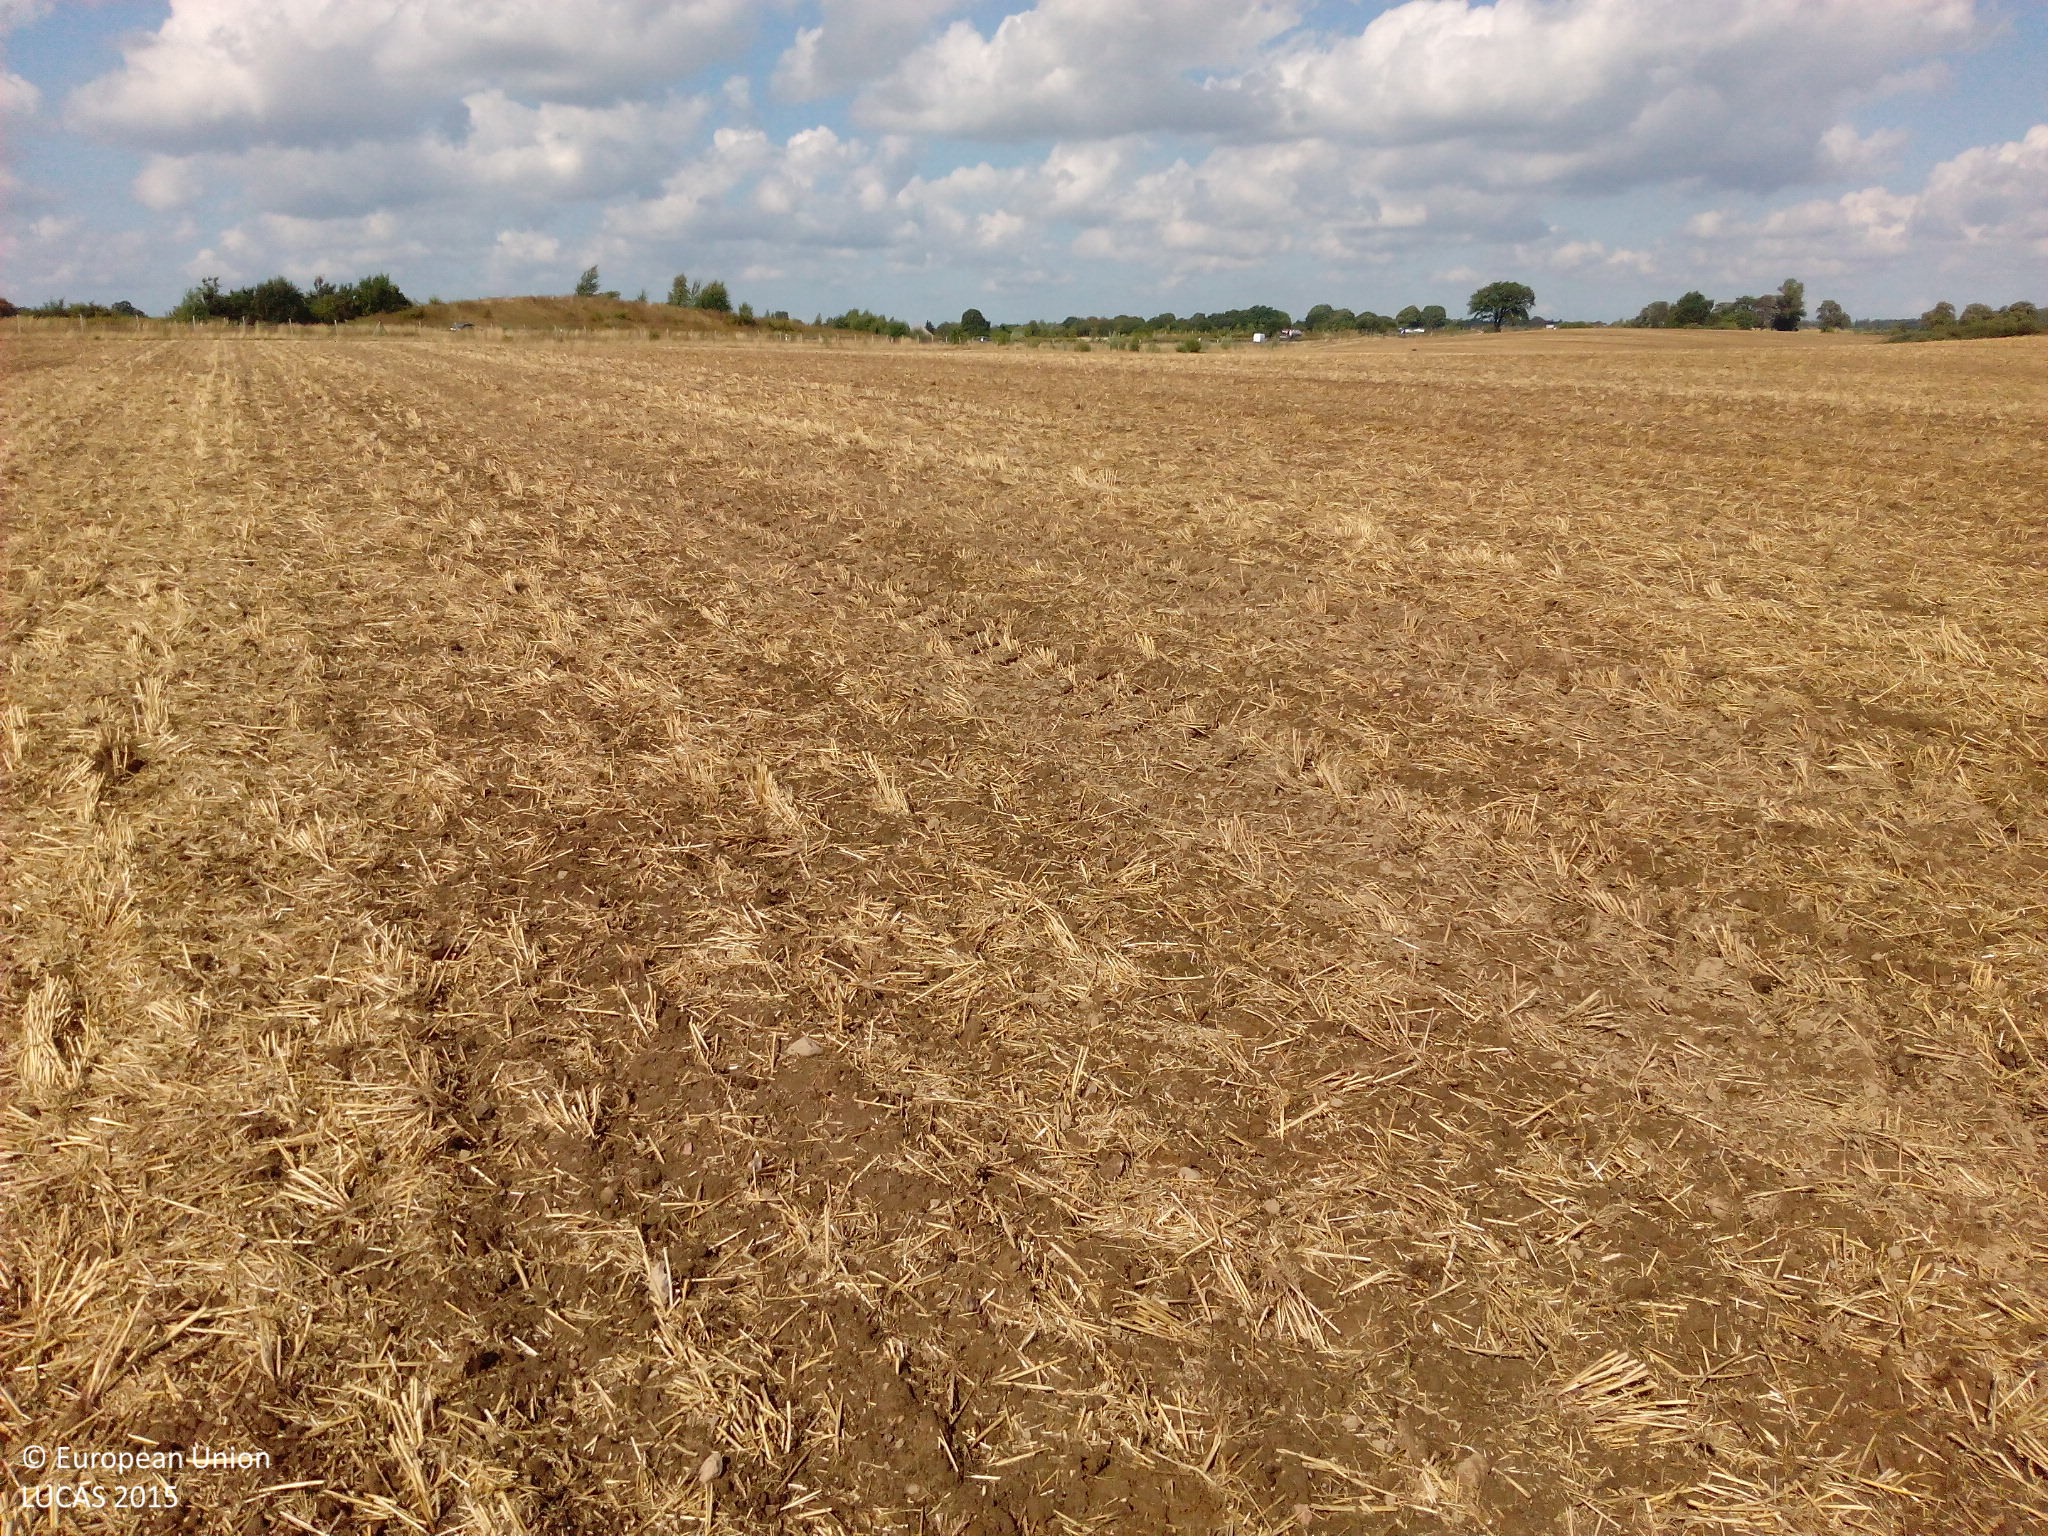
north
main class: Cropland
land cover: Common wheat
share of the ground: 25 - 50 %
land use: Agriculture (excluding fallow land and kitchen gardens)
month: August
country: DE
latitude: 54.0392
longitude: 12.6103
